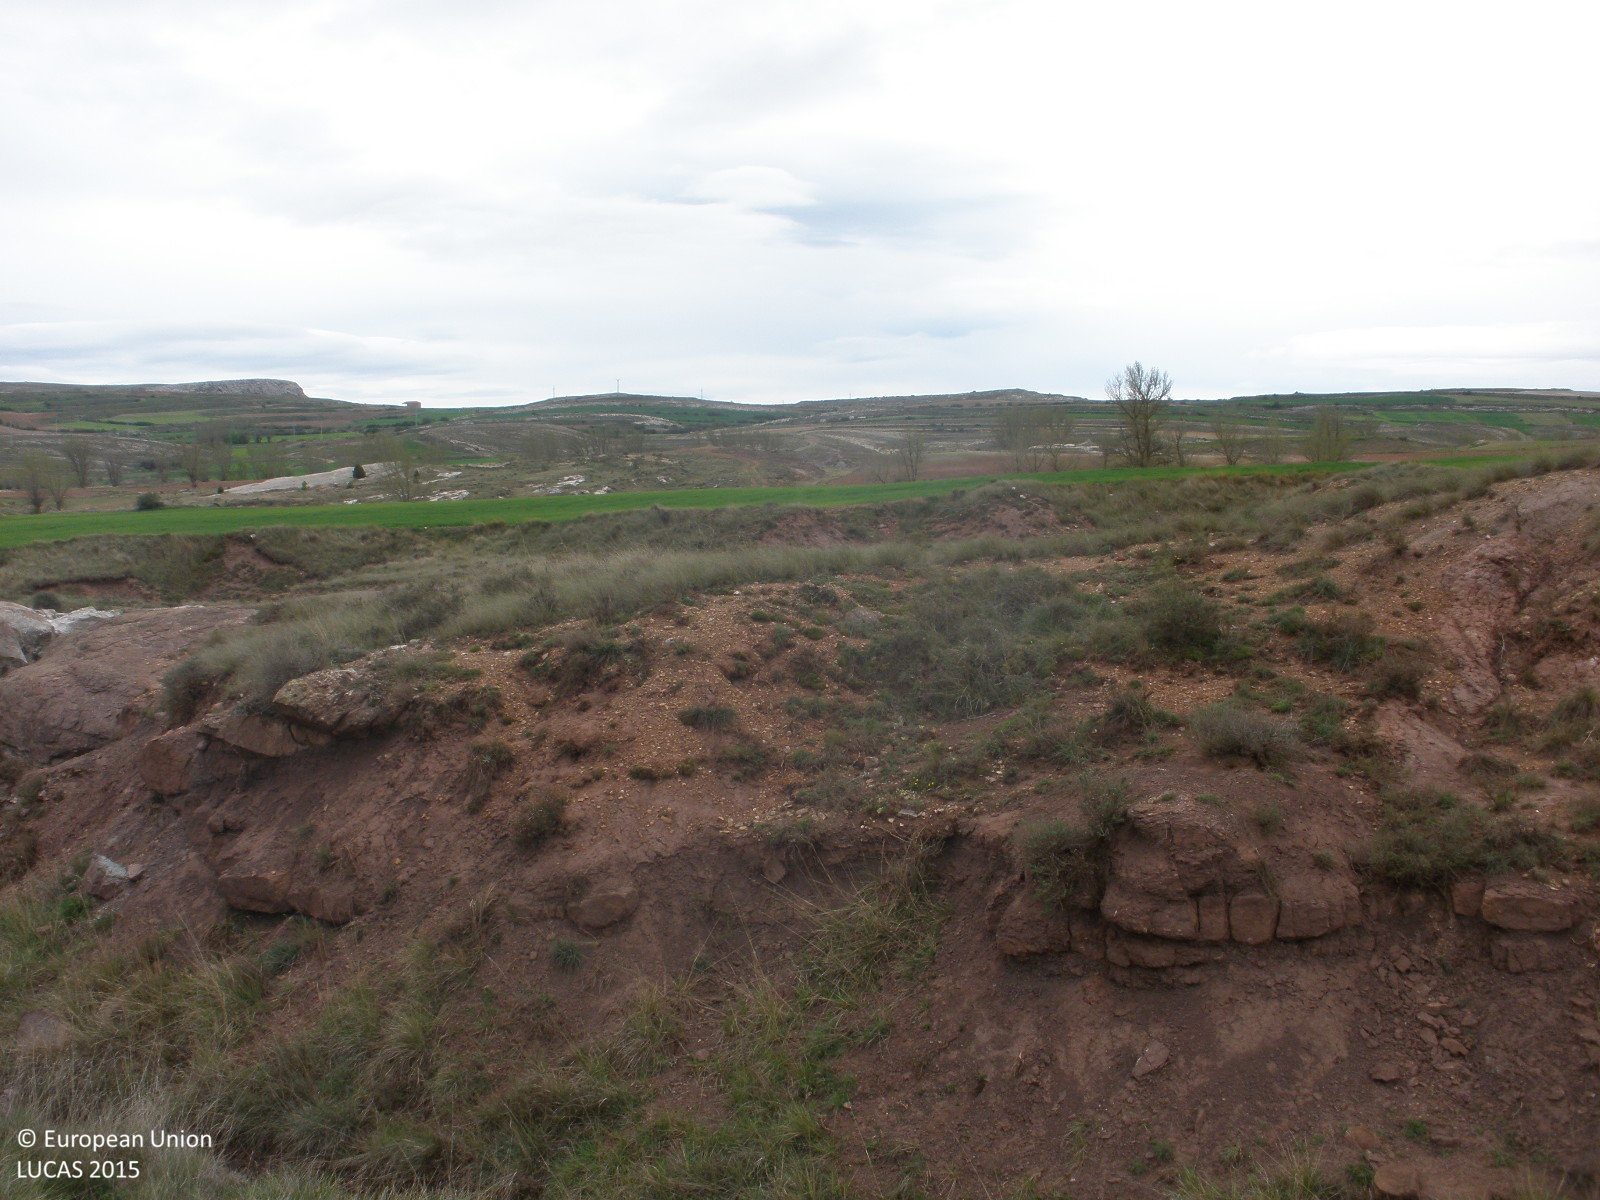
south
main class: Shrubland
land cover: Shrubland without tree cover
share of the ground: 25 - 50 %
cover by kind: consolidated bare surface 50 %, shrubs 30 %, herbaceous plants 20 %
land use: Semi-natural and natural areas not in use
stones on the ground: 10 - 25 %
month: May
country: ES
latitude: 40.5609
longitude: -0.8175
